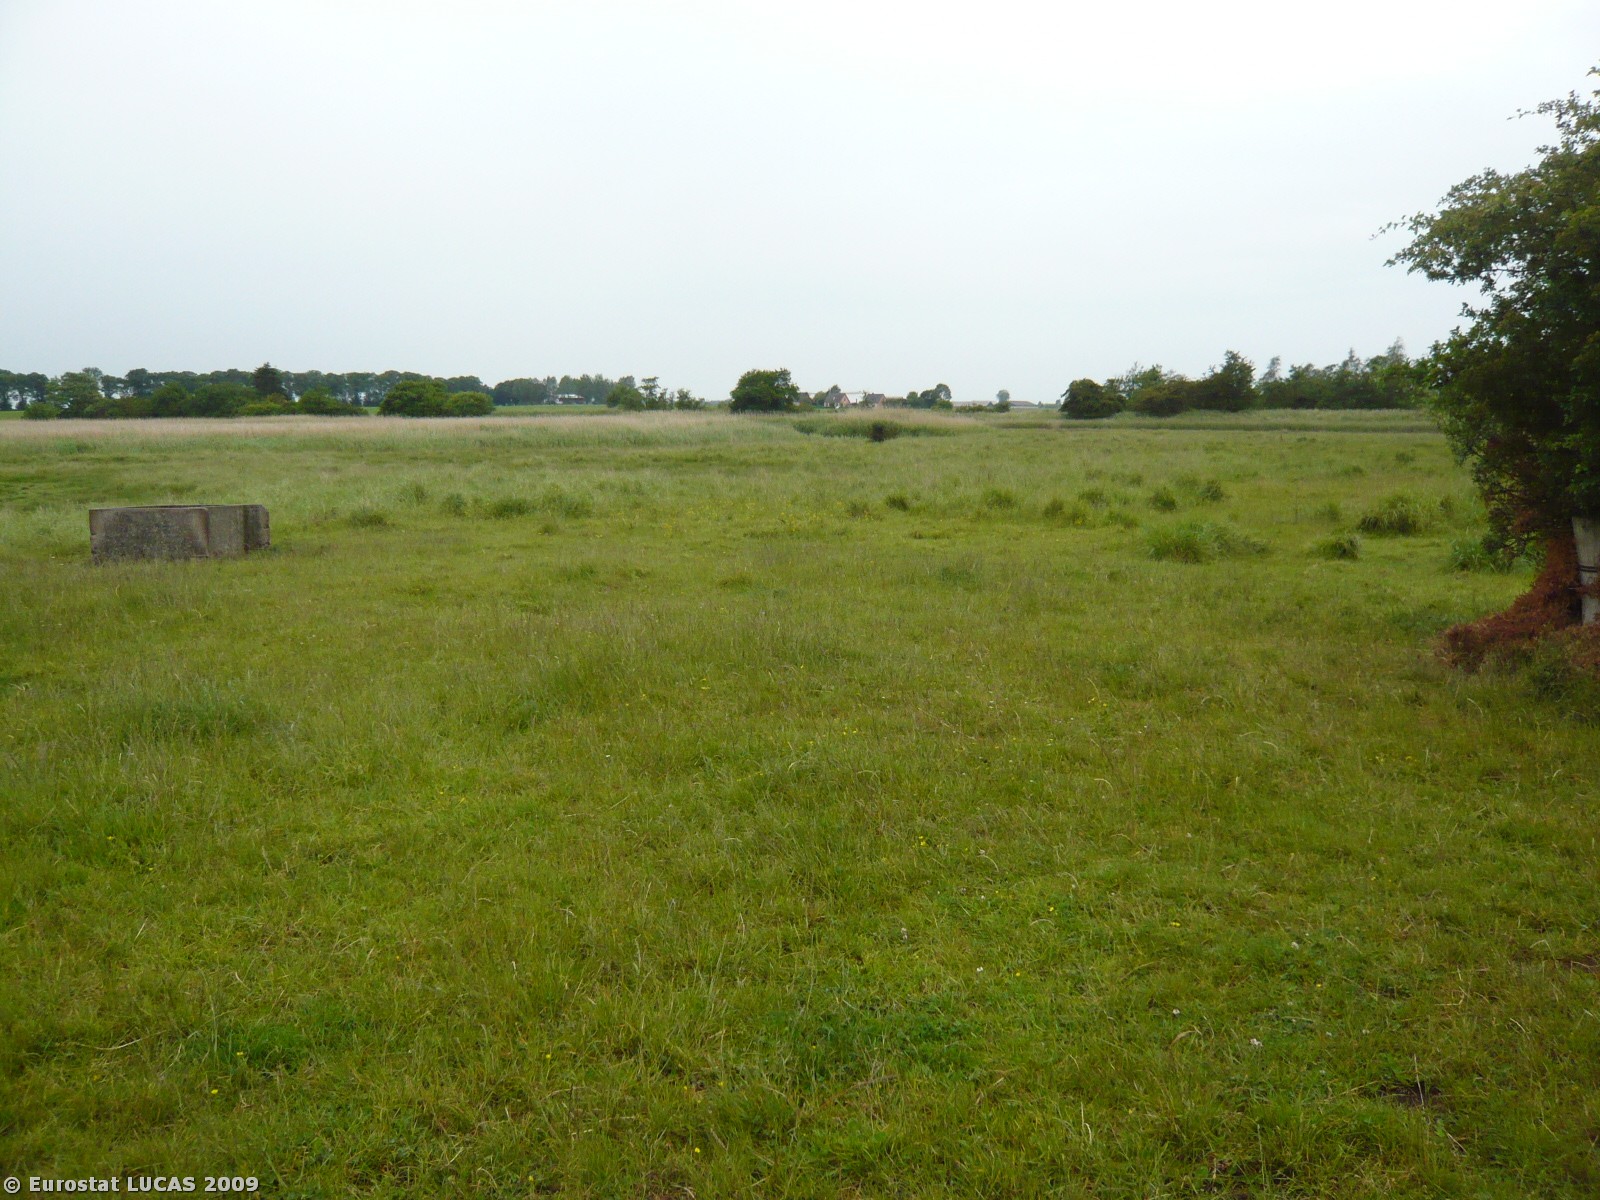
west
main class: Grassland
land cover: Grassland without tree/shrub cover
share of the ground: > 75 %
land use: Agriculture (excluding fallow land and kitchen gardens)
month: June
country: DK
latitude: 54.7366
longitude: 11.8160
